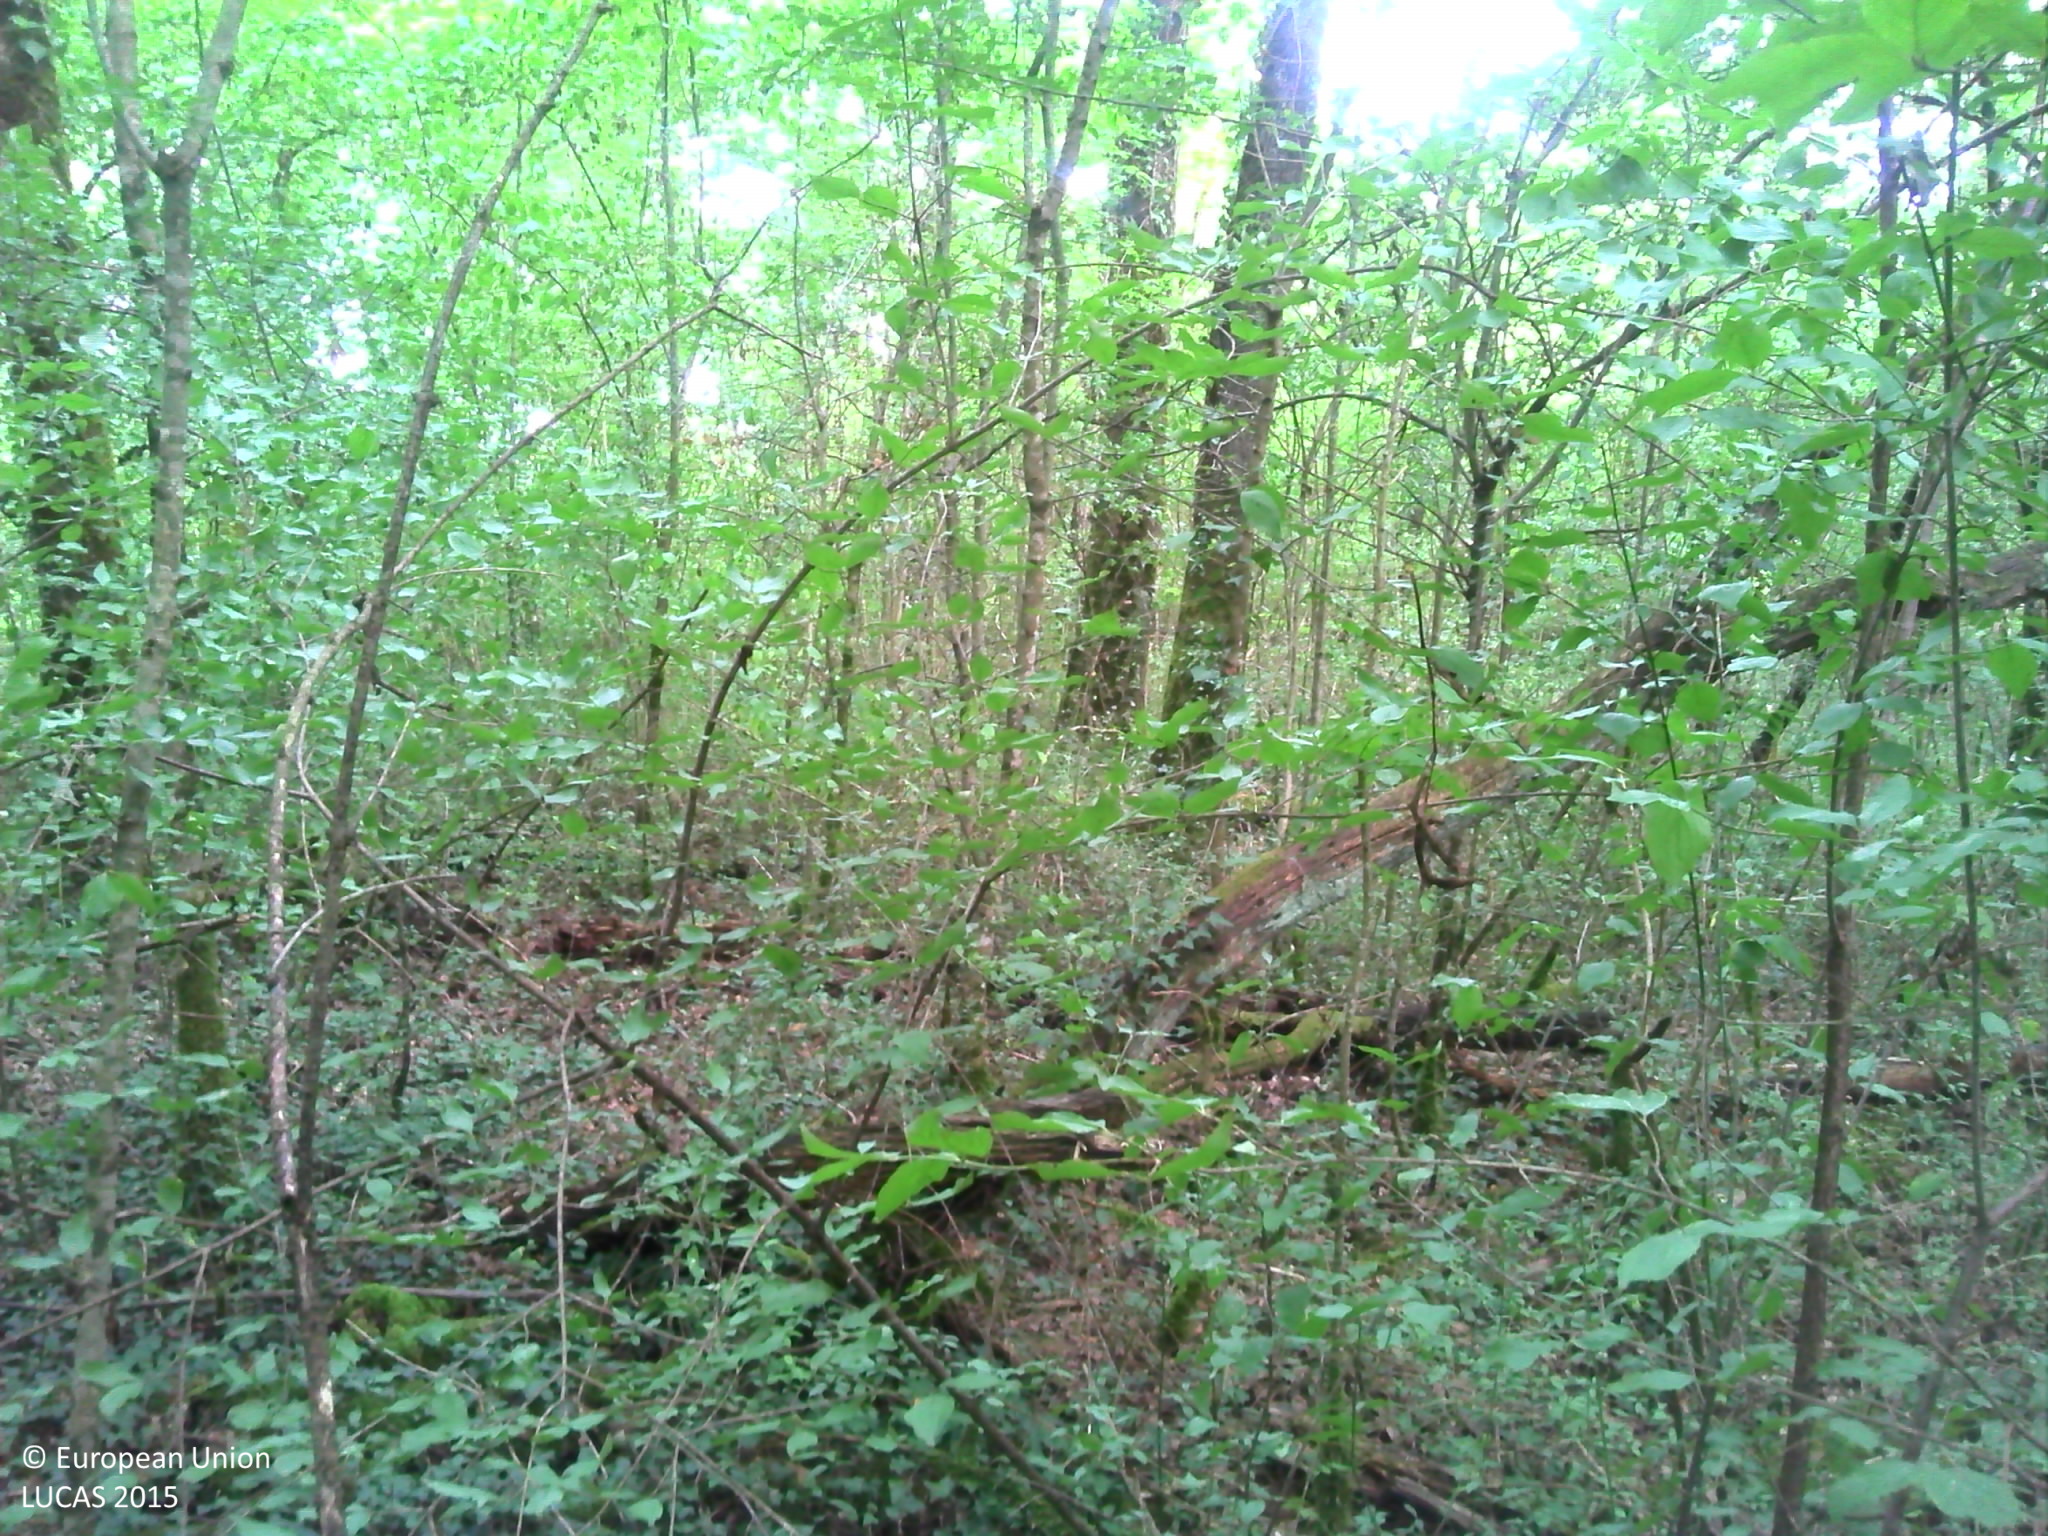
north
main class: Woodland
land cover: Broadleaved woodland
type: mesophytic deciduous forest
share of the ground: > 75 %
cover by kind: broadleaved forest trees 90 %, shrubs 5 %, herbaceous plants 5 %
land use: Forestry
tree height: > 5 m
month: July
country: FR
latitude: 45.7668
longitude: 5.4393
